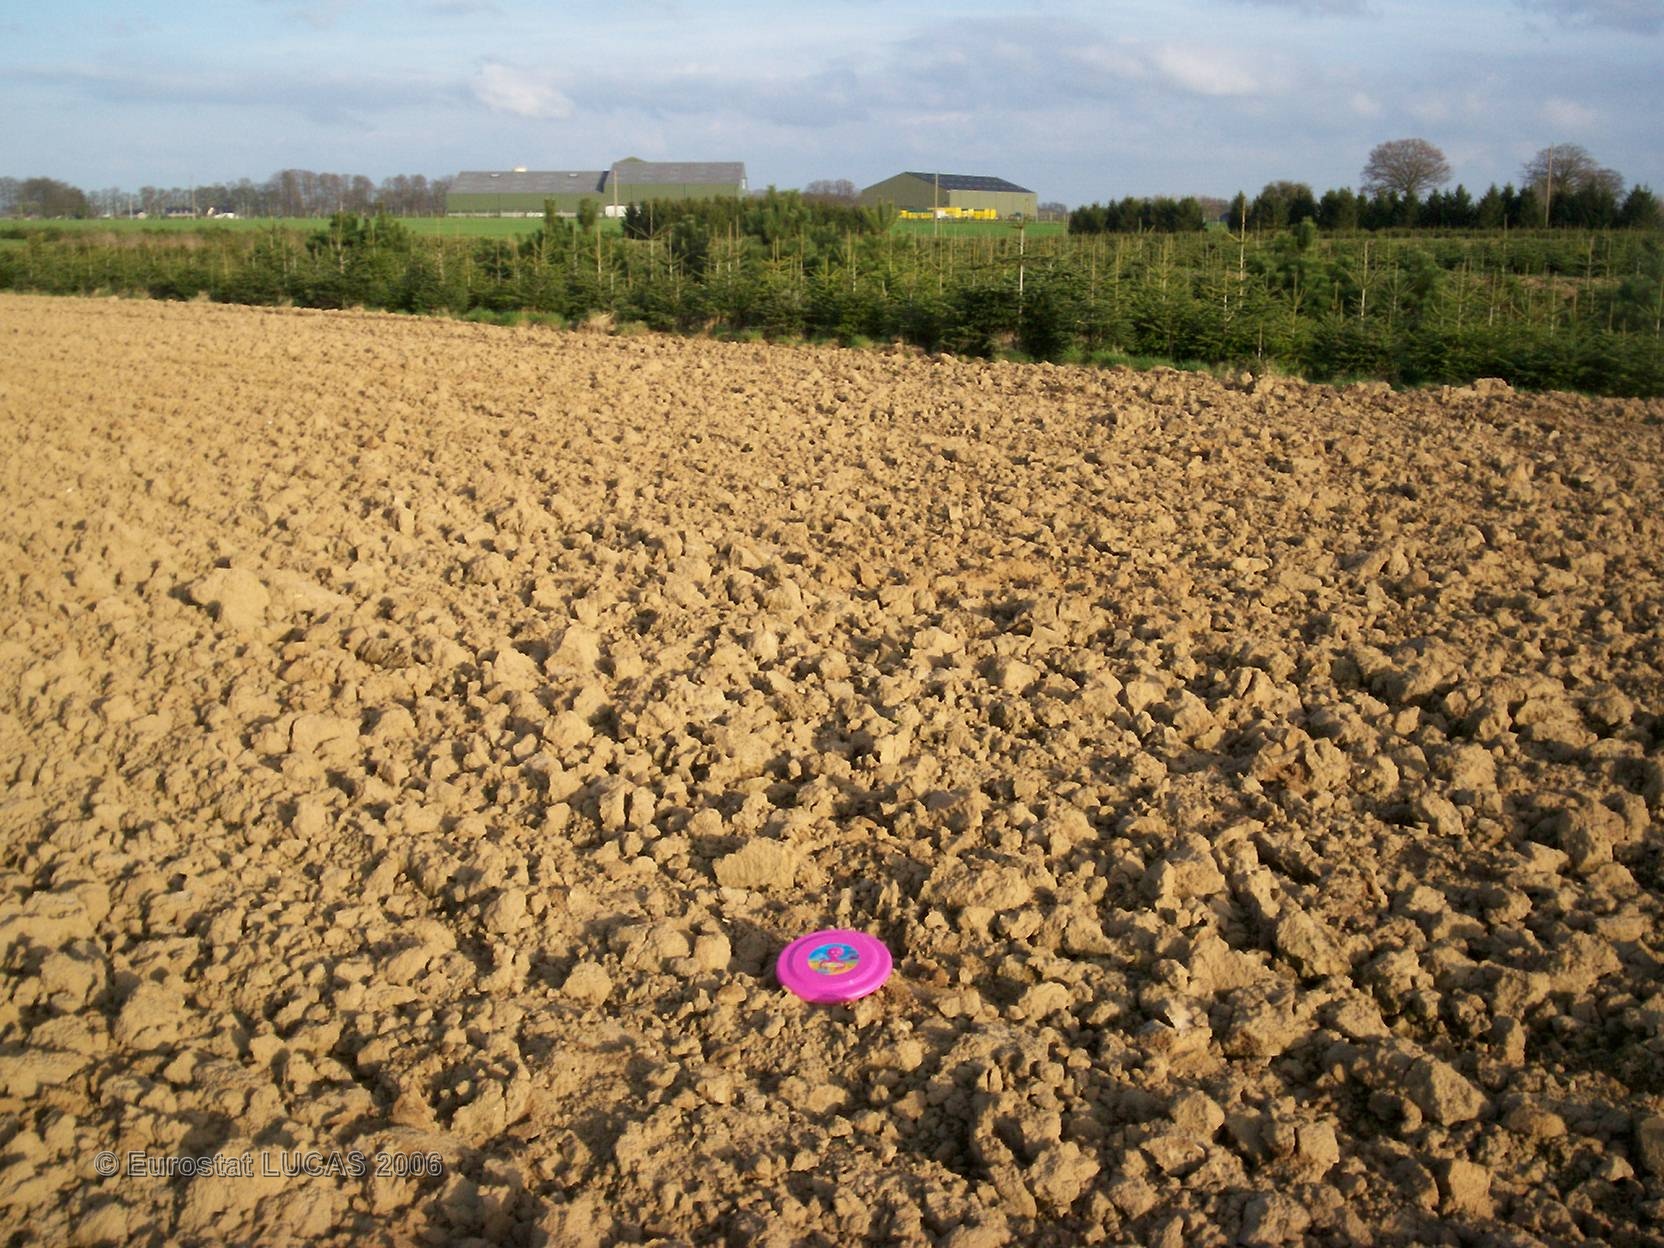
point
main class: Cropland
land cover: Maize
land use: Agriculture (excluding fallow land and kitchen gardens)
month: April
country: FR
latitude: 49.6749
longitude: 0.8999
